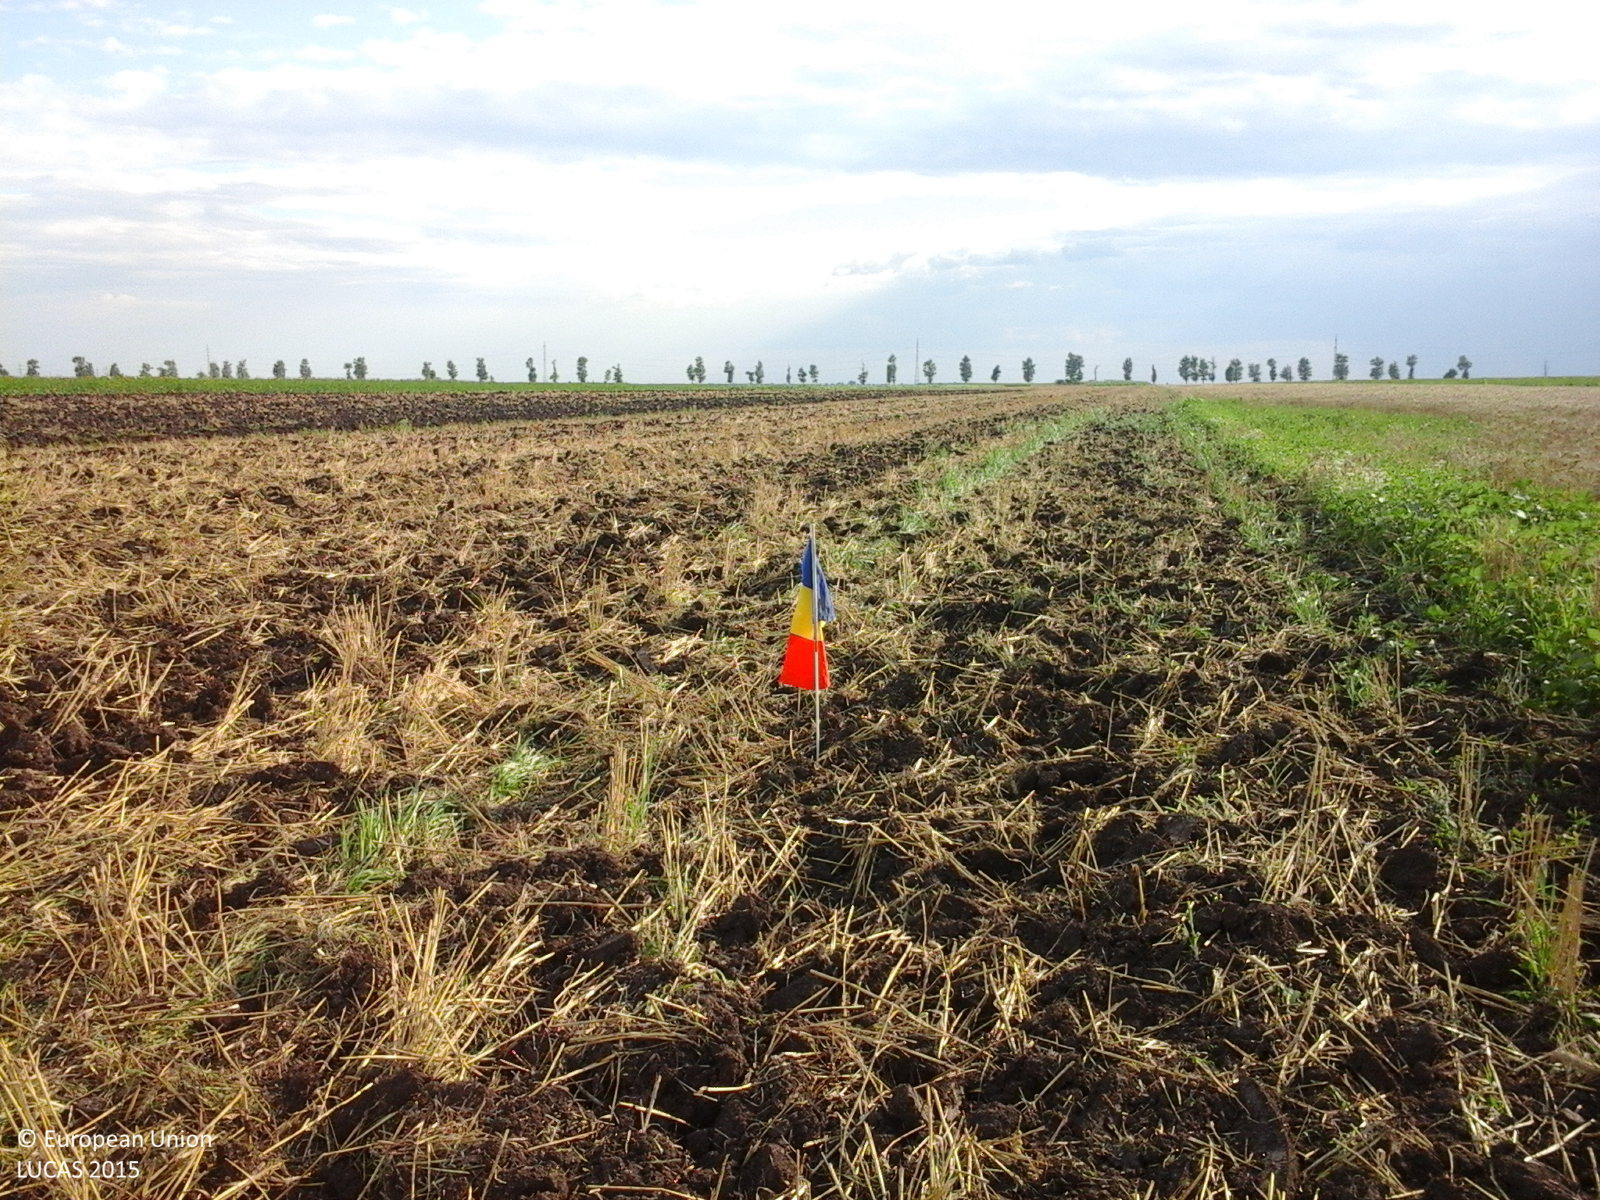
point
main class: Cropland
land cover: Common wheat
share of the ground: < 10 %
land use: Agriculture (excluding fallow land and kitchen gardens)
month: July
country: RO
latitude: 44.1803
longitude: 25.5379
